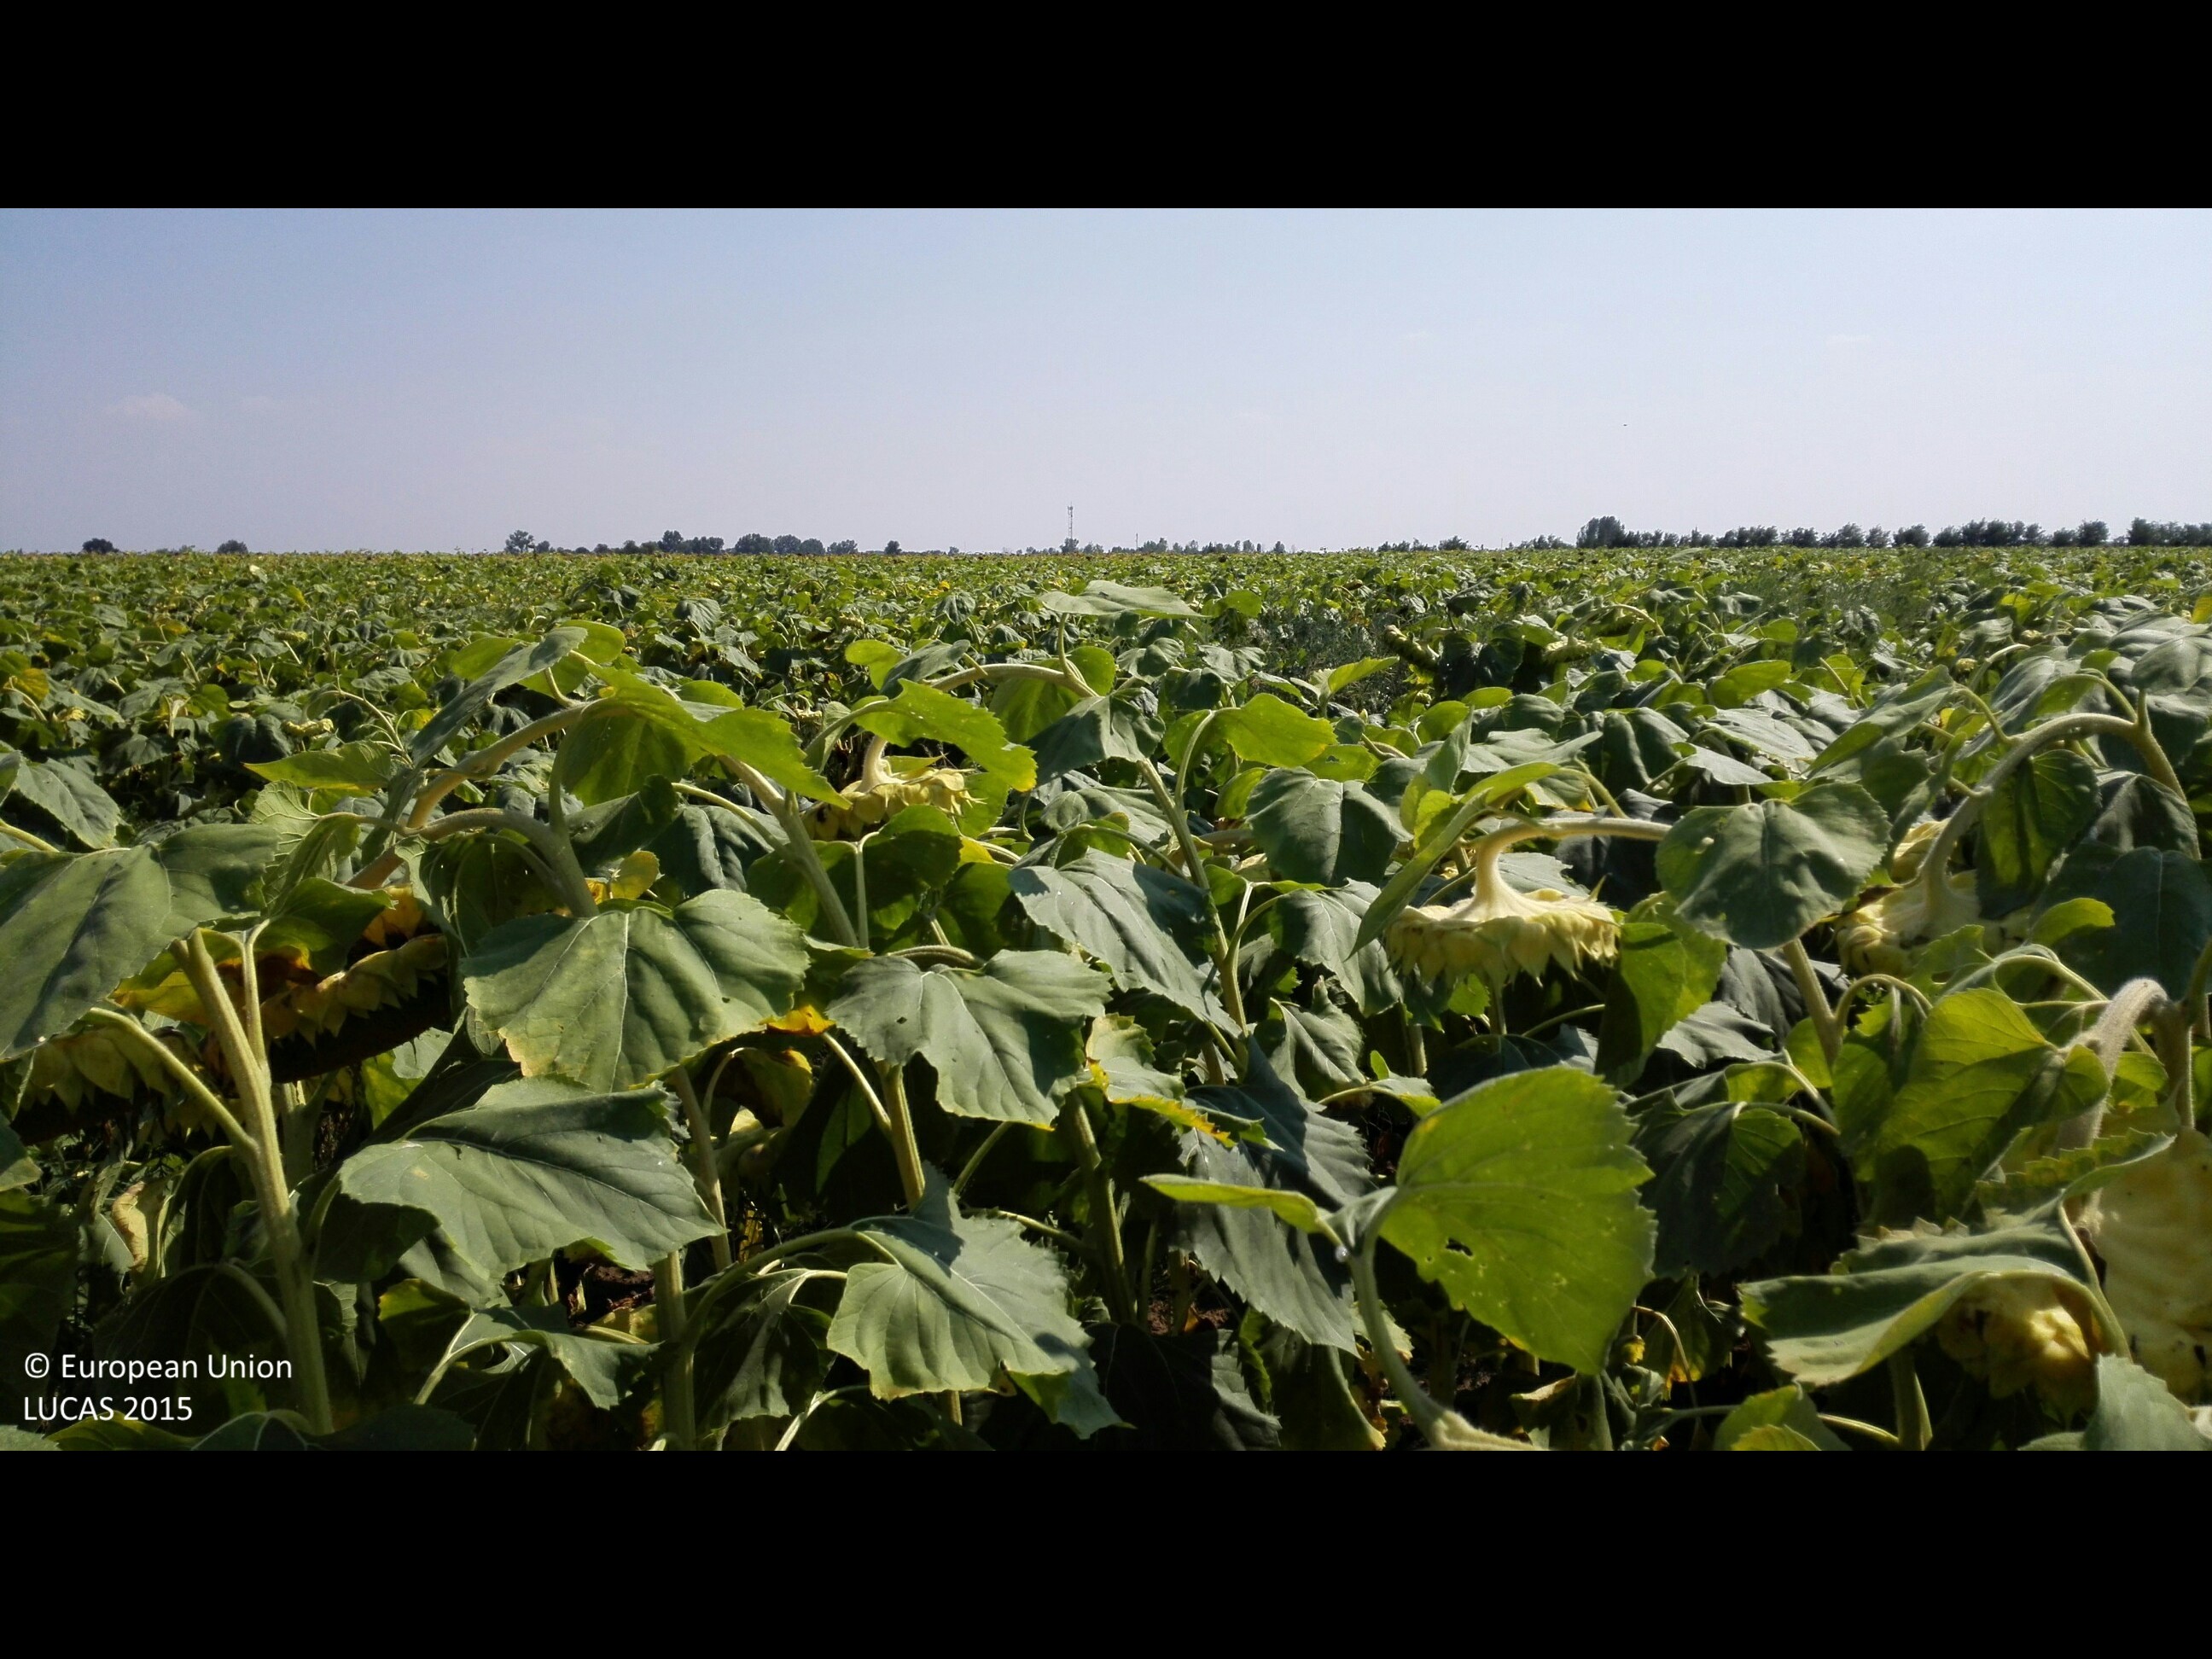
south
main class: Cropland
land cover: Sunflower
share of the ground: > 75 %
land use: Agriculture (excluding fallow land and kitchen gardens)
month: August
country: HU
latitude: 47.3748
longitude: 21.5786
